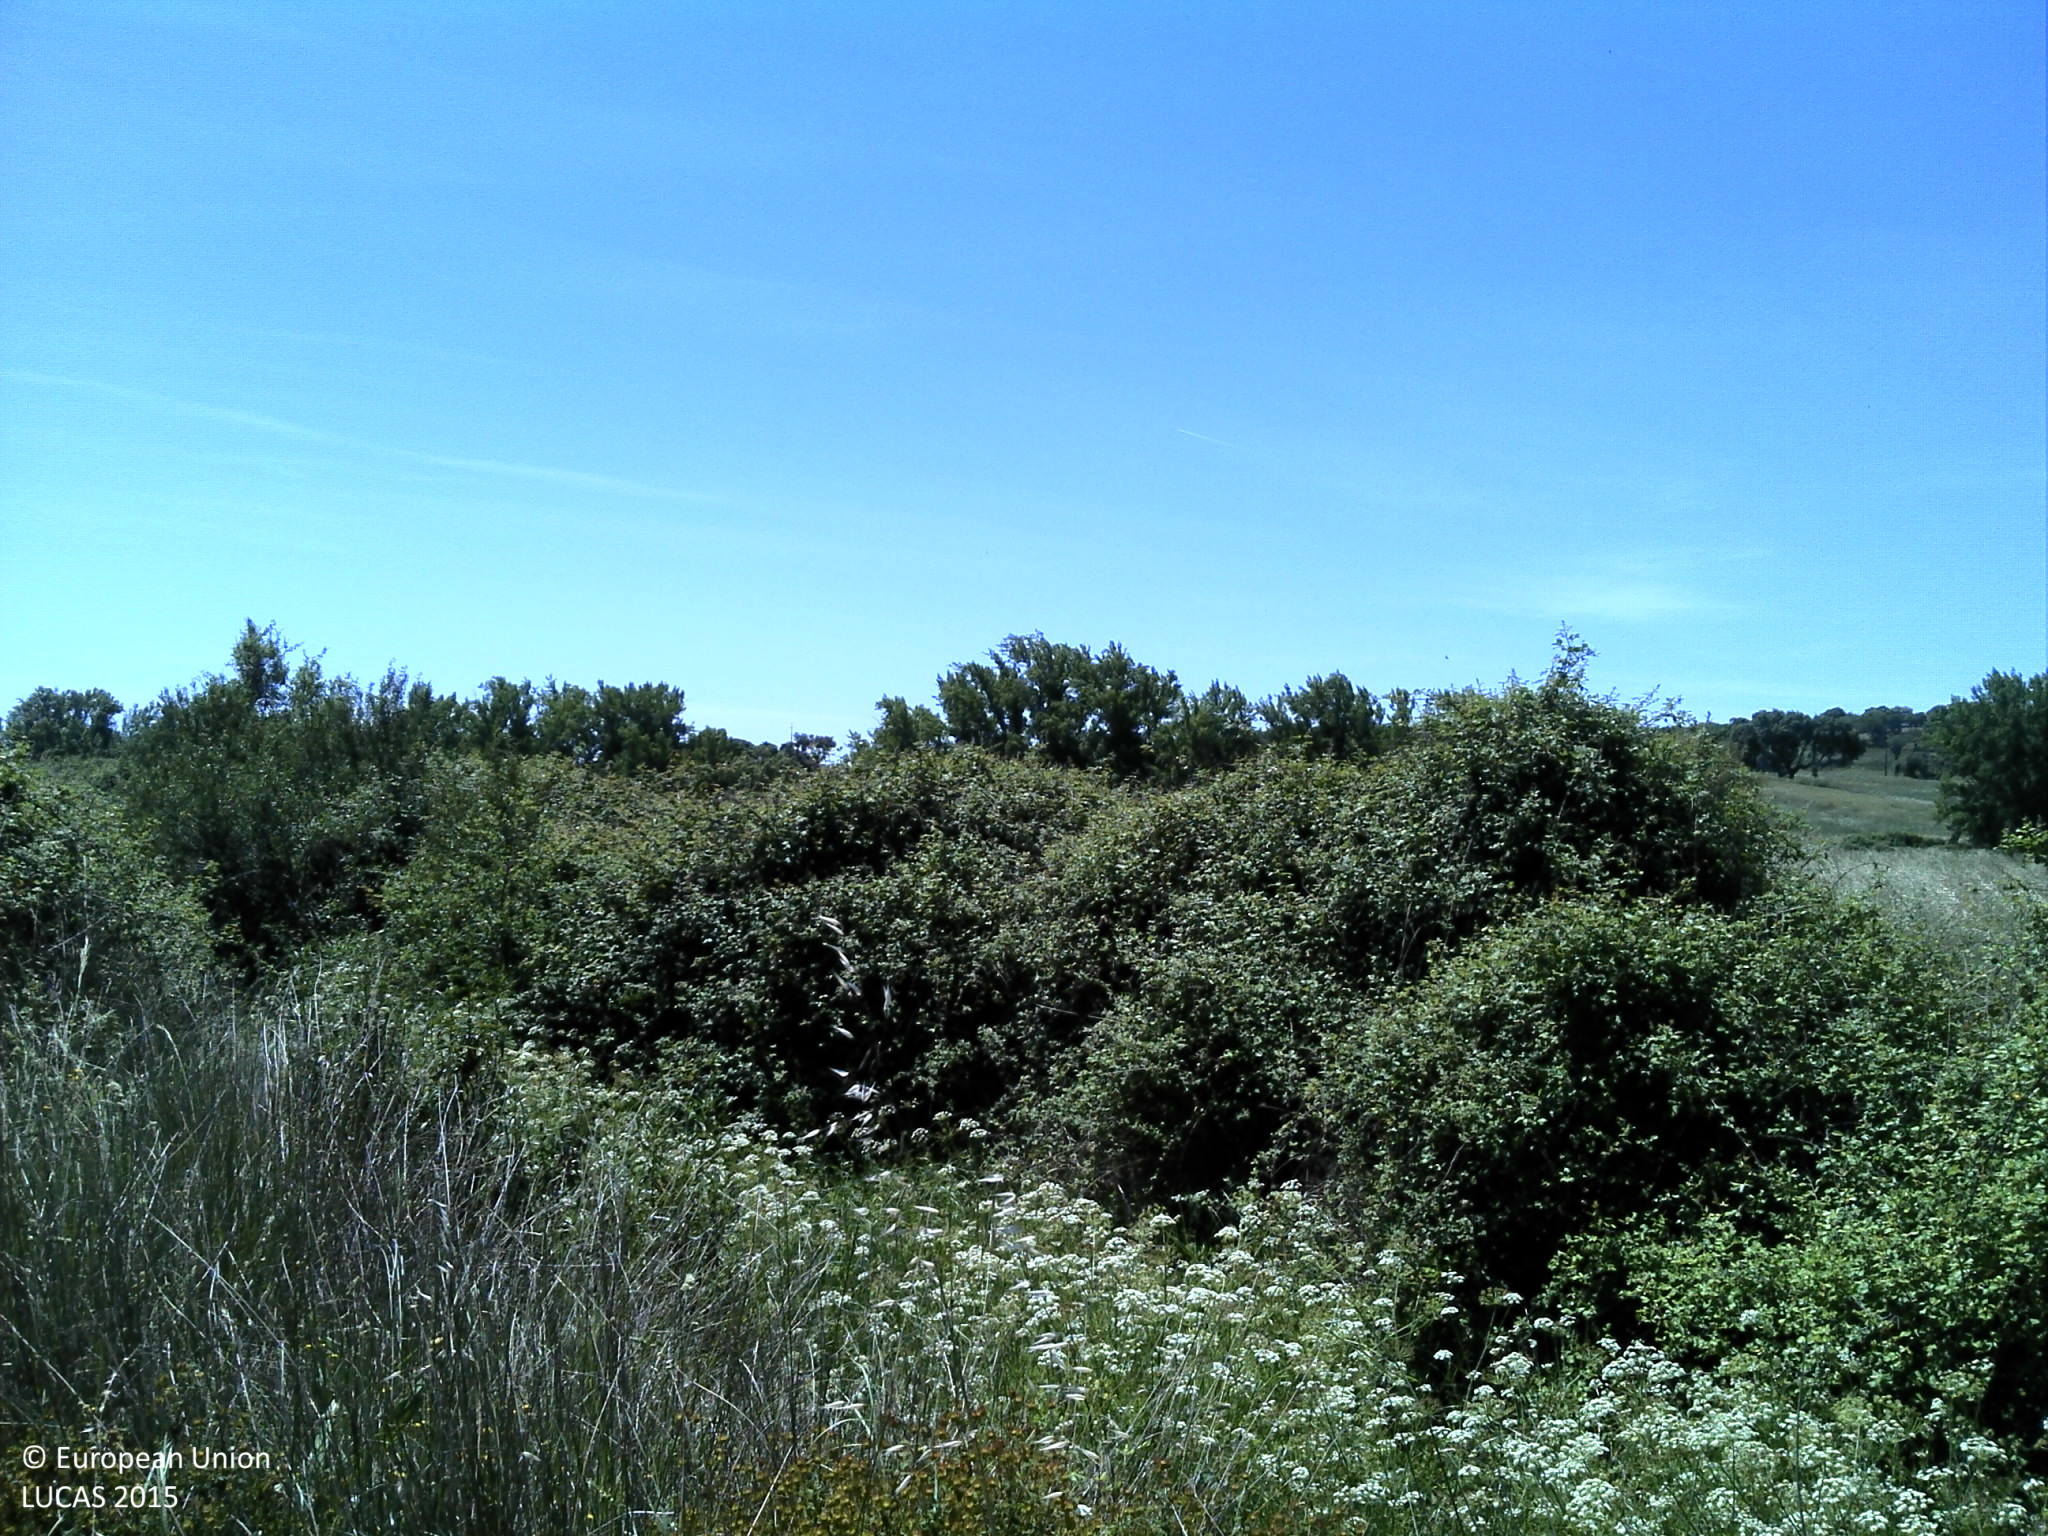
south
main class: Grassland
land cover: Grassland with sparse tree/shrub cover
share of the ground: > 75 %
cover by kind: herbaceous plants 90 %, broadleaved forest trees 5 %, unconsolidated bare surface 5 %
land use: Agriculture (excluding fallow land and kitchen gardens)
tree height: > 5 m
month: May
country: PT
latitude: 39.2026
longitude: -7.8718
